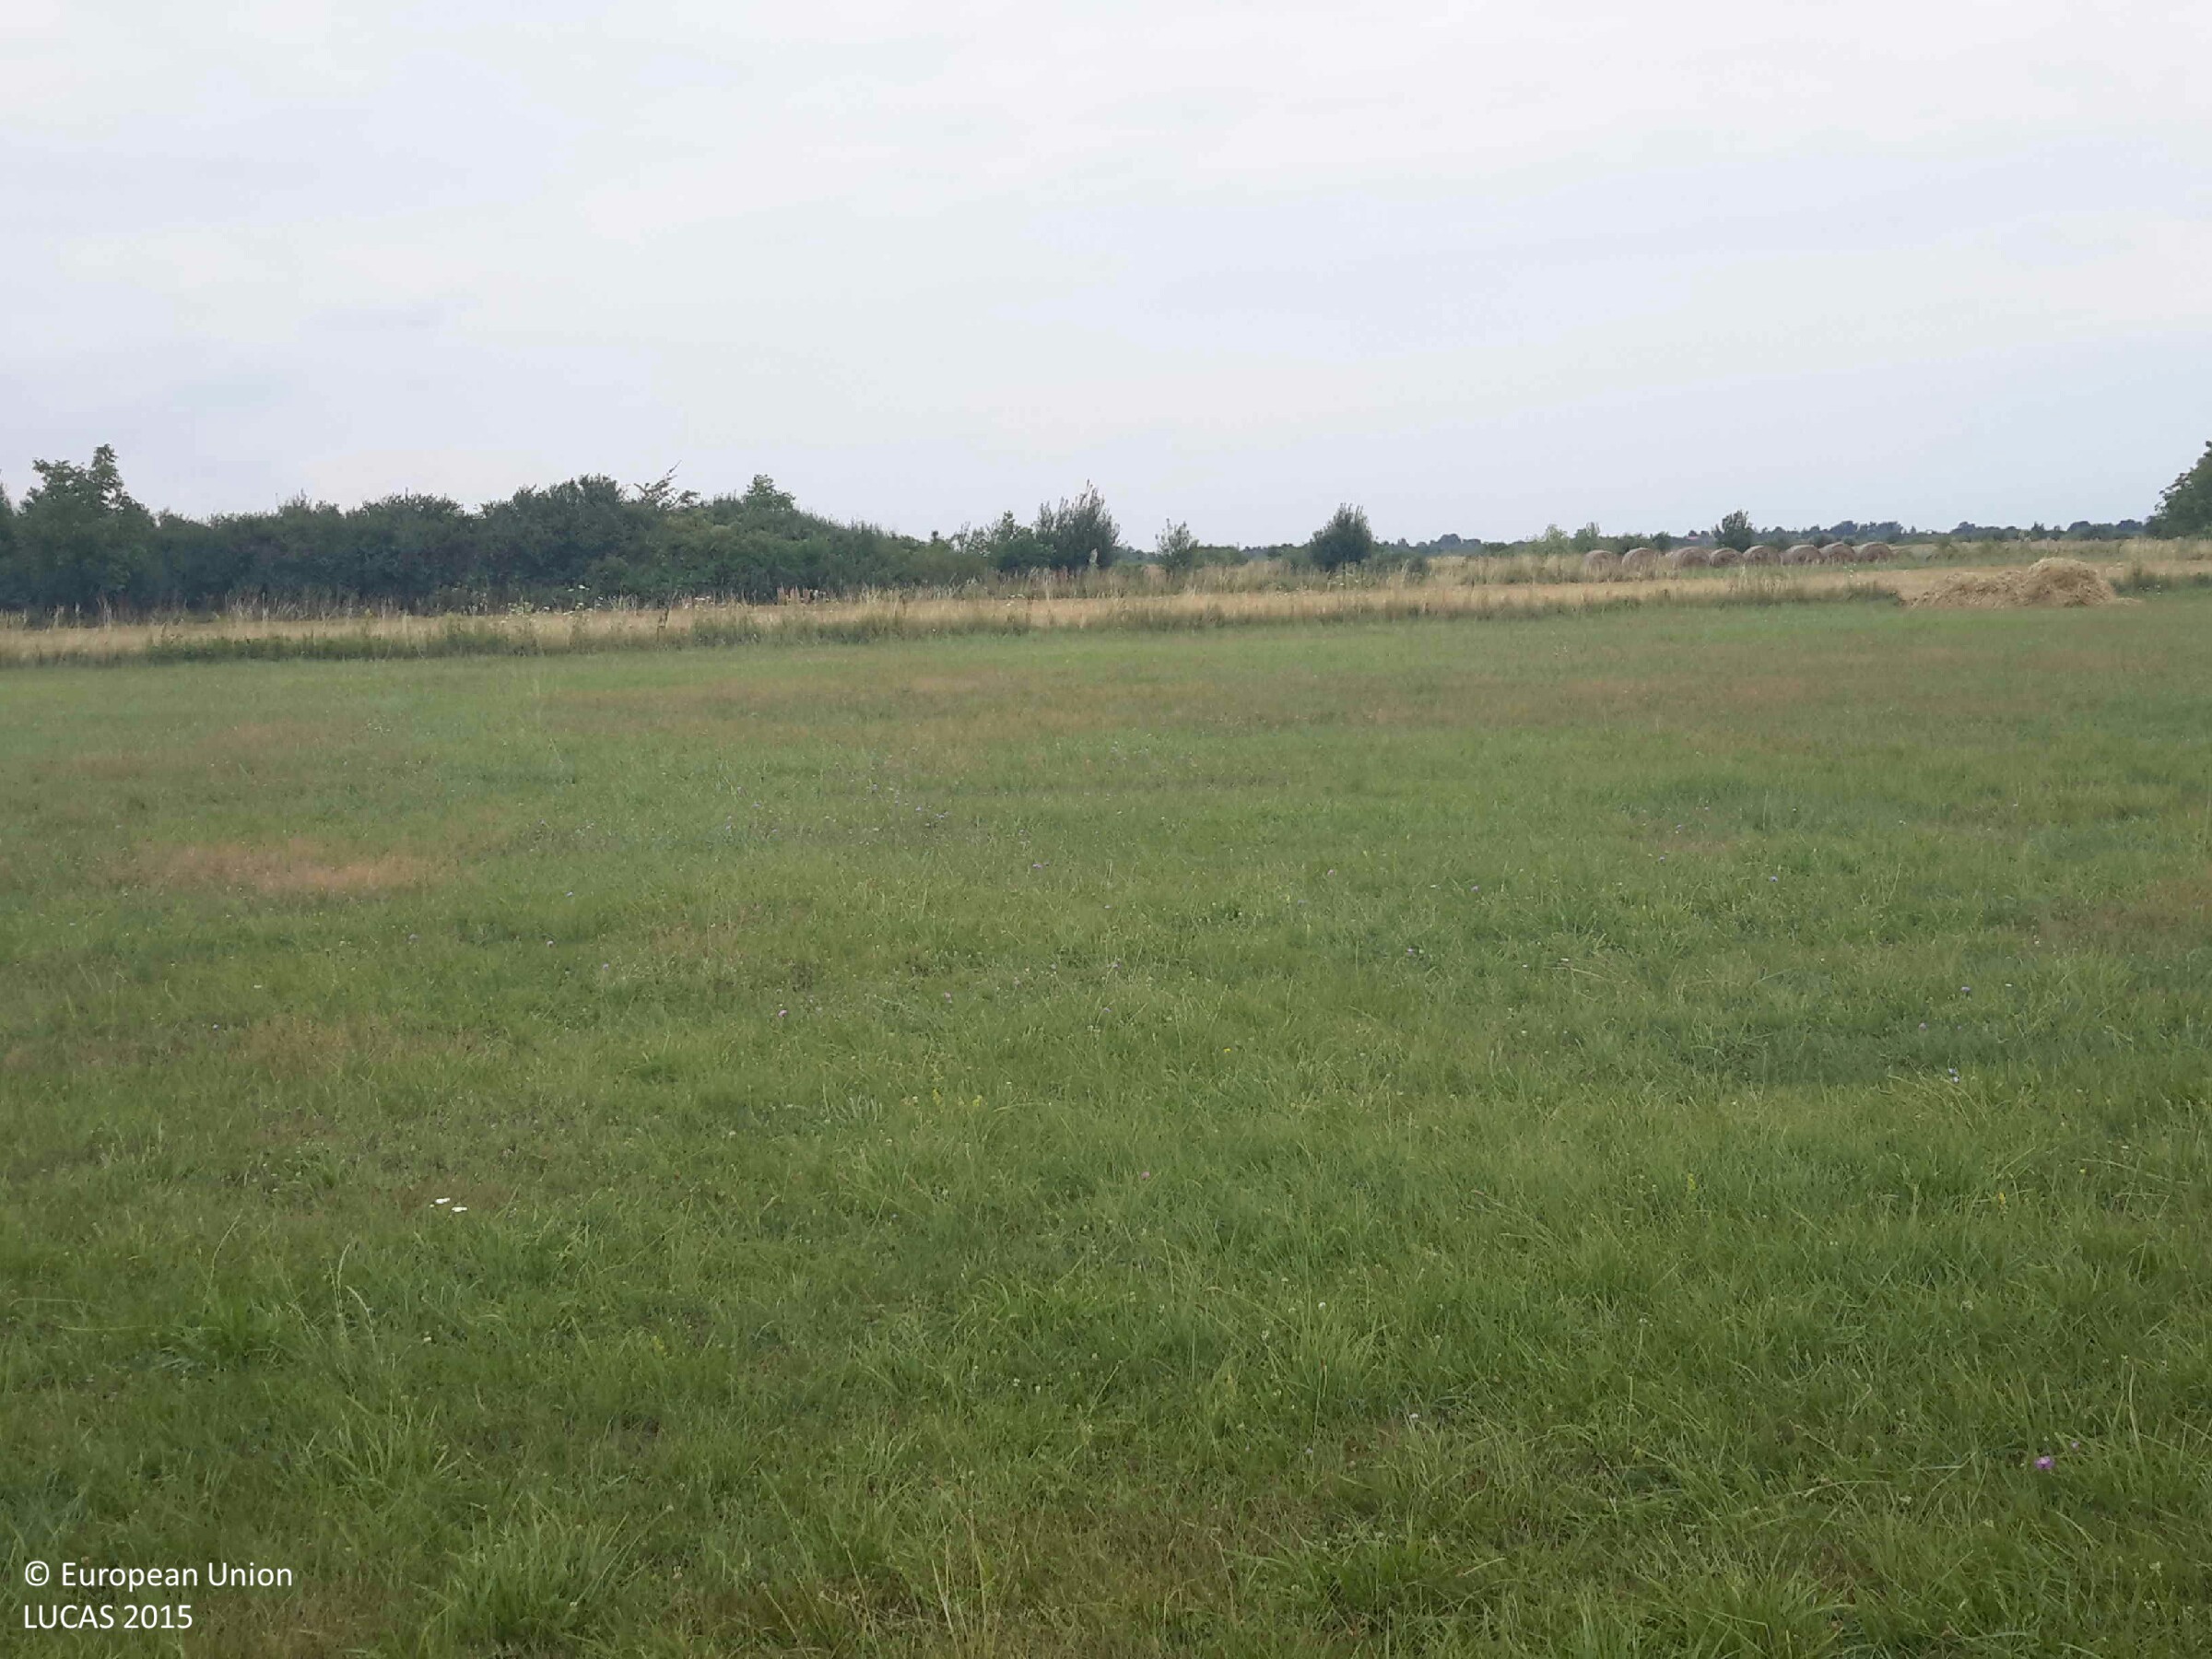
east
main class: Grassland
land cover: Grassland without tree/shrub cover
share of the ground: > 75 %
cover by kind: herbaceous plants 100 %
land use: Agriculture (excluding fallow land and kitchen gardens)
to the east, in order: Grassland without tree/shrub cover; Common wheat; Shrubland with sparse tree cover; Lucerne; Ditches and canals; Grassland with sparse tree/shrub cover; Tracks; Shruby margins; Ditches and canals; Grassland with sparse tree/shrub cover
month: July
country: HU
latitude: 47.2837
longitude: 16.6275
